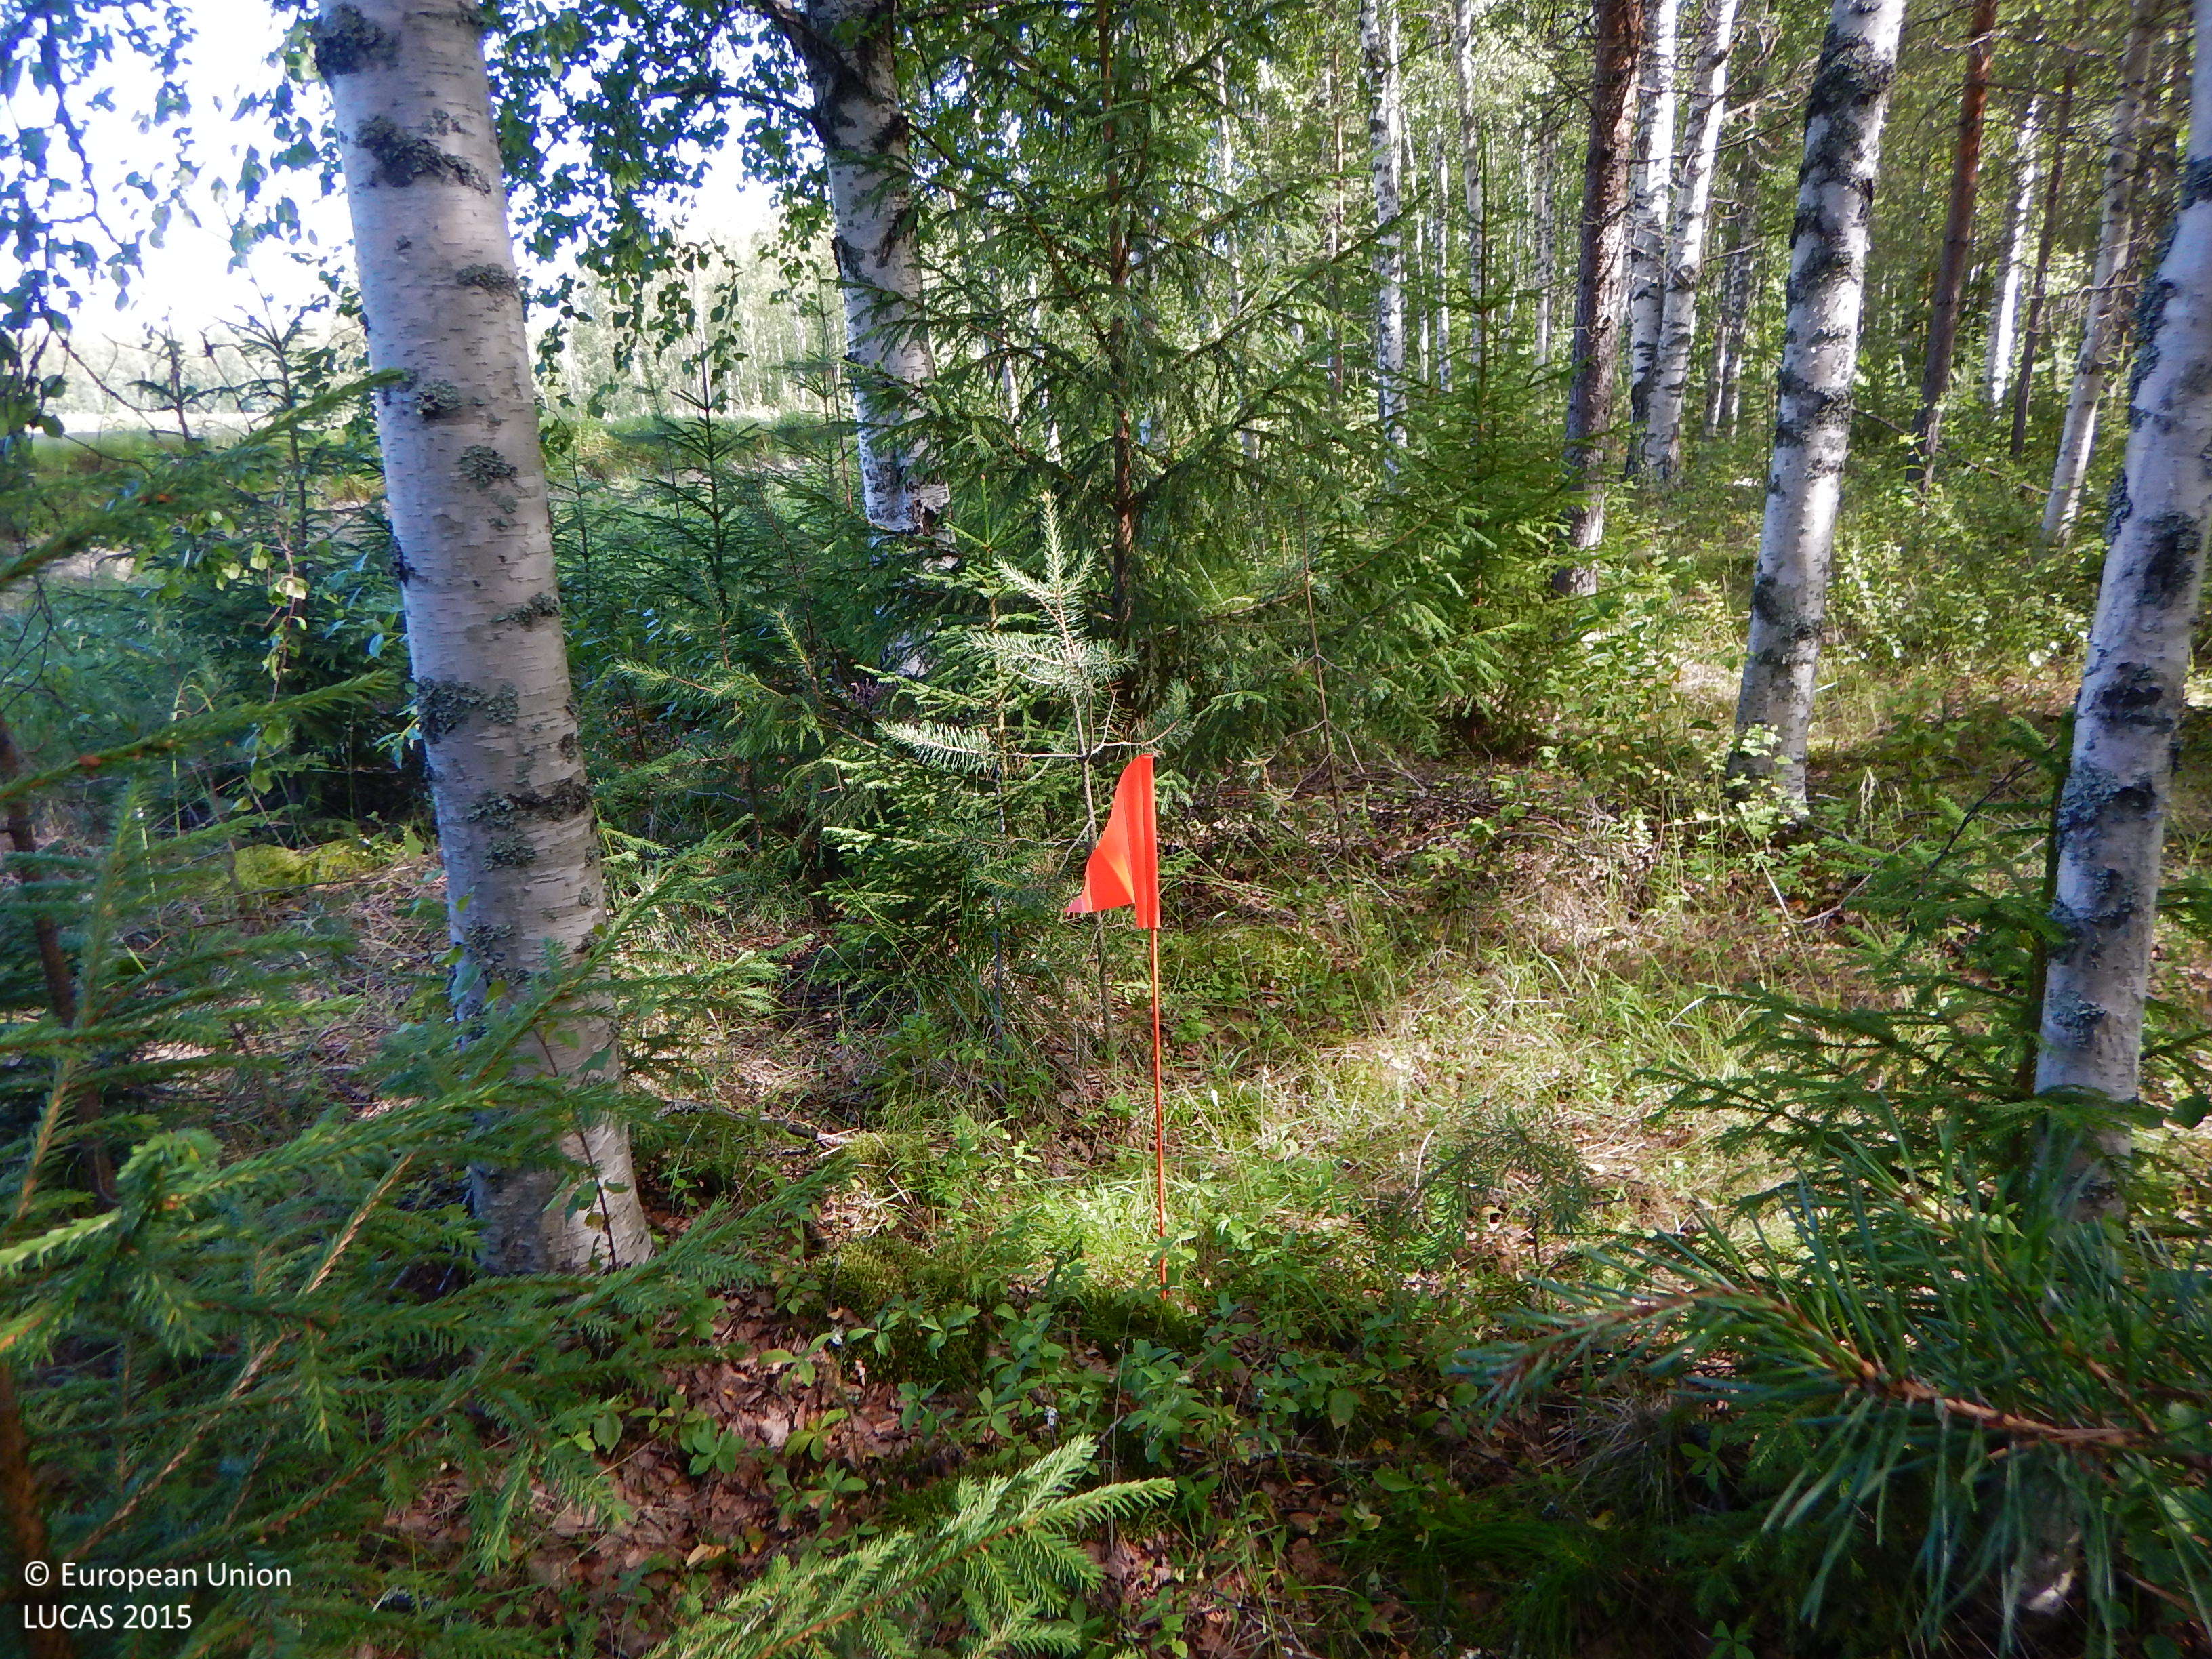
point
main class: Woodland
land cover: Broadleaved woodland
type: boreal forest
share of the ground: 50 - 75 %
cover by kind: broadleaved forest trees 45 %, shrubs 20 %, coniferous forest trees 15 %, herbaceous plants 10 %, lichens and mosses 10 %
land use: Forestry
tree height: > 5 m
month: July
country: SE
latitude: 64.7958
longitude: 21.0697
